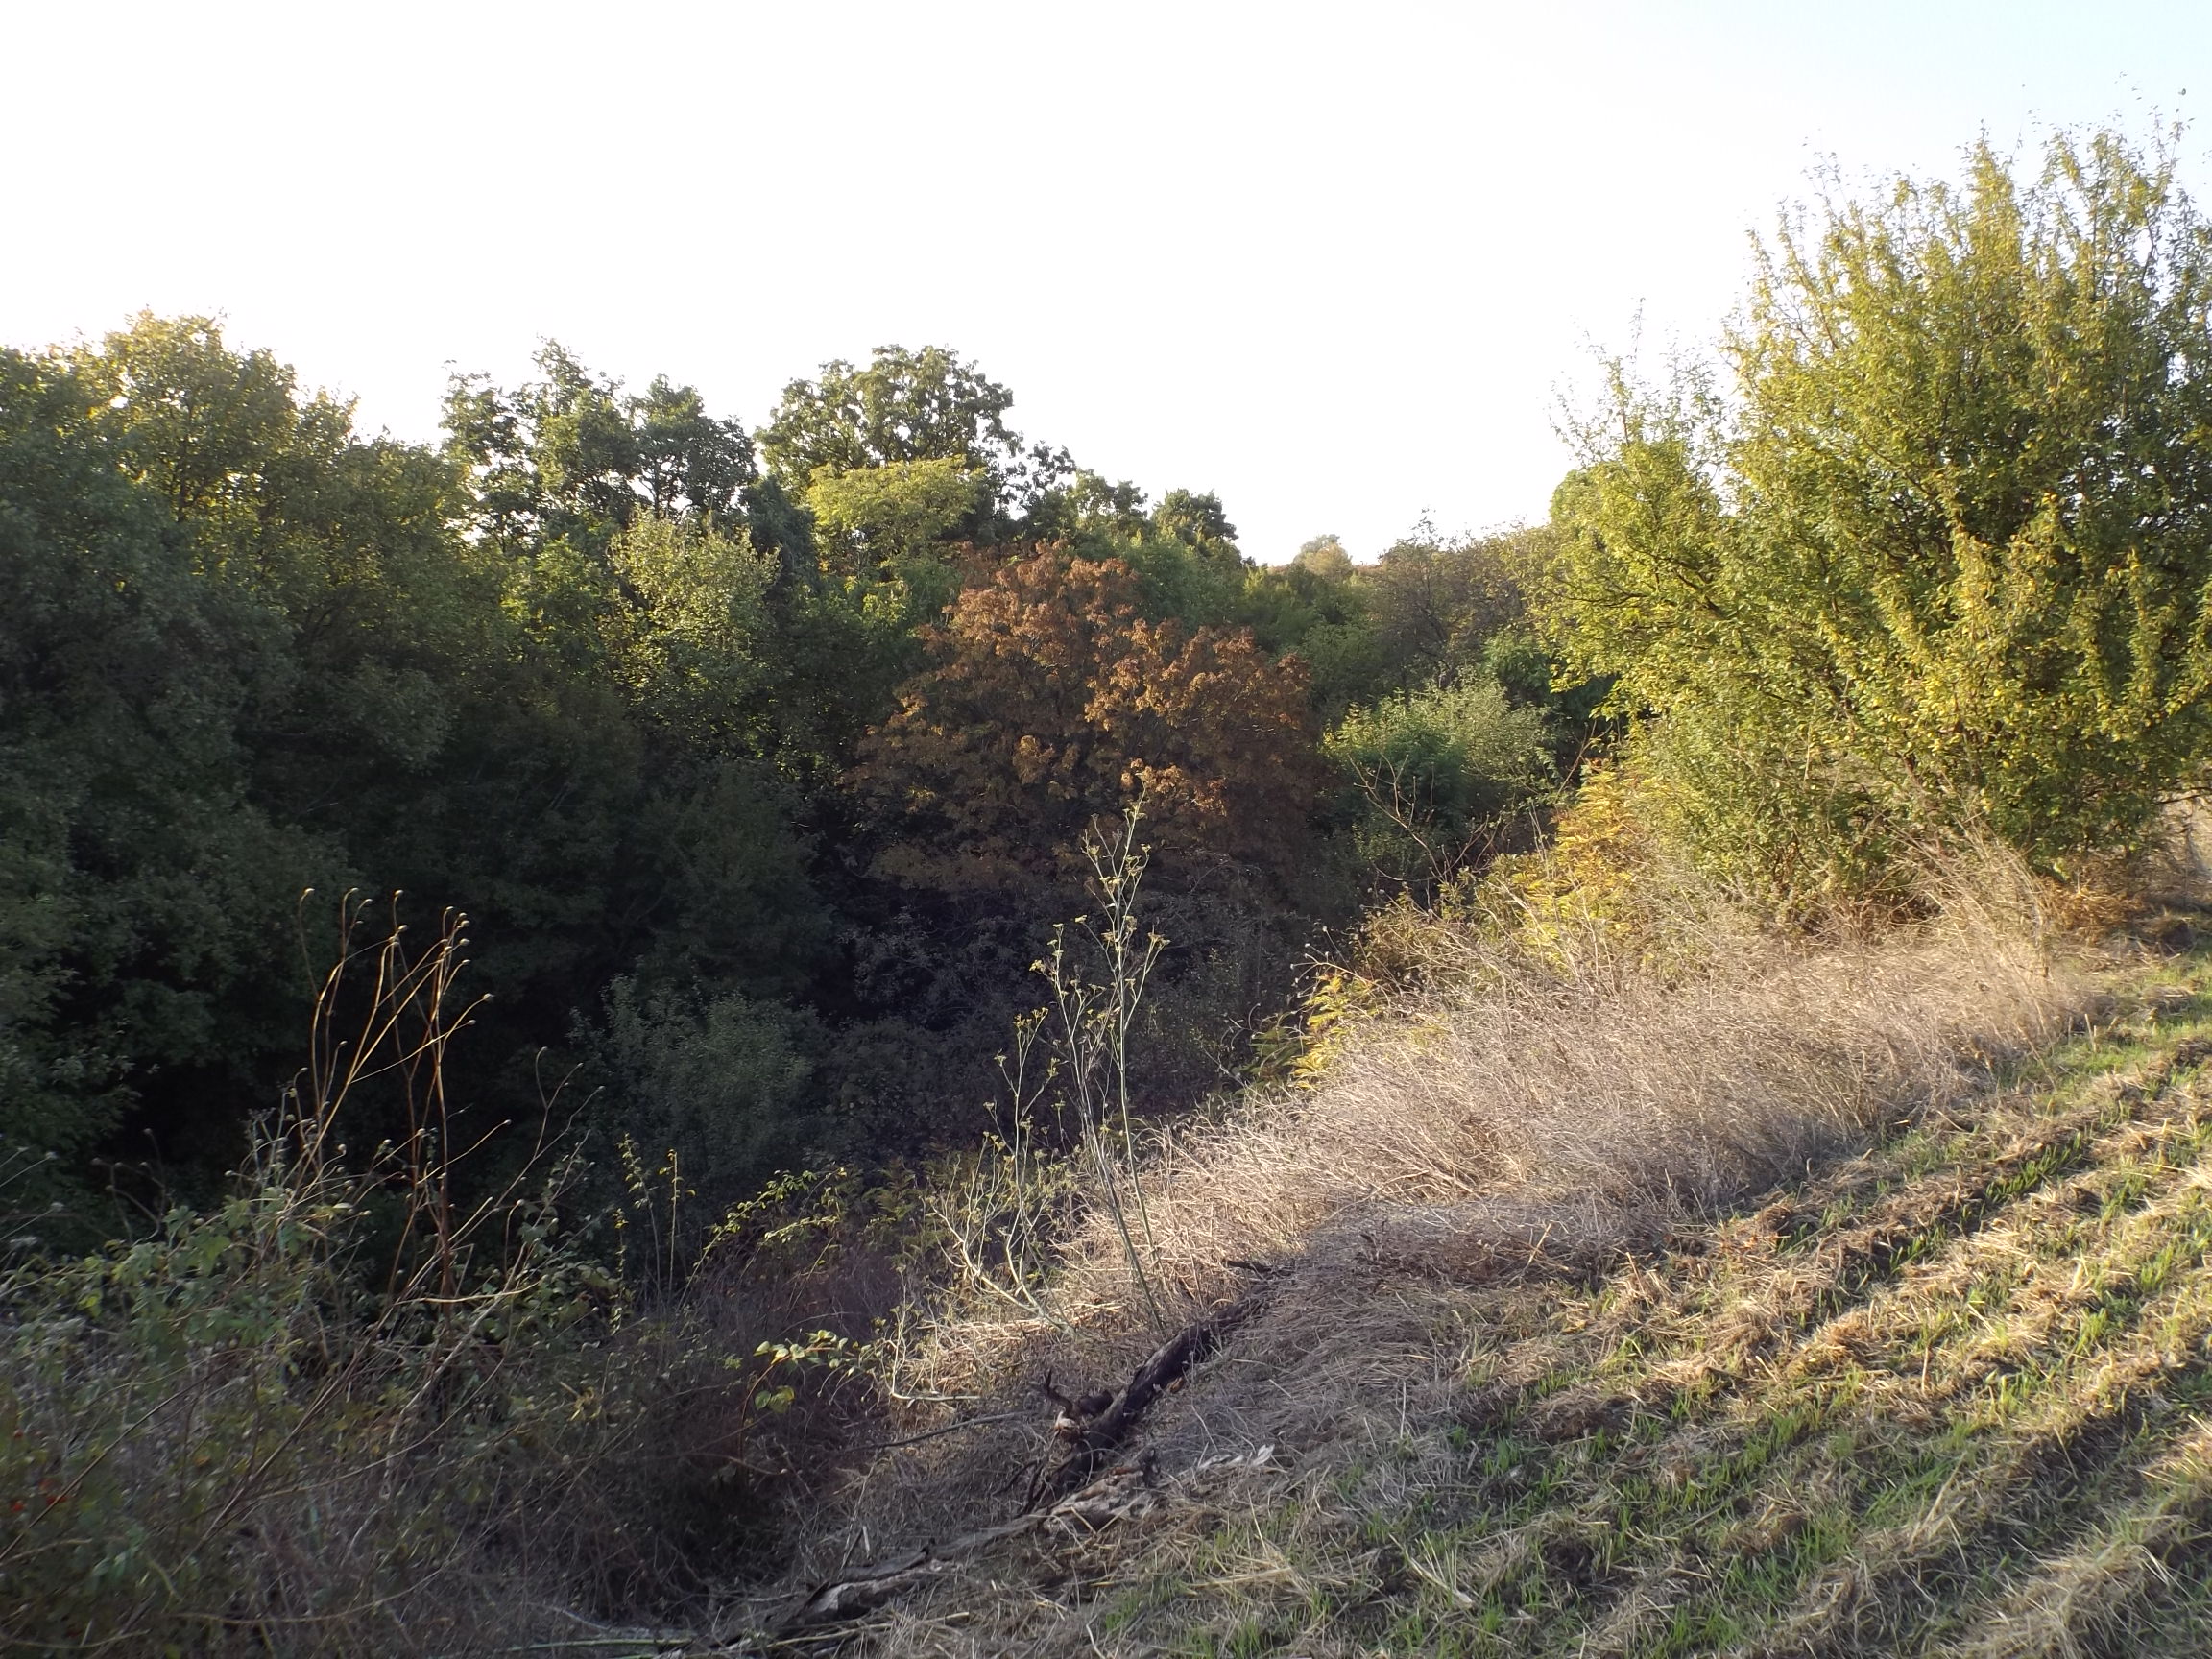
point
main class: Grassland
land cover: Grassland with sparse tree/shrub cover
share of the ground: > 75 %
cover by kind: herbaceous plants 90 %, broadleaved forest trees 5 %, shrubs 5 %
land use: Semi-natural and natural areas not in use
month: October
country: BG
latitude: 42.8931
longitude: 27.8776
